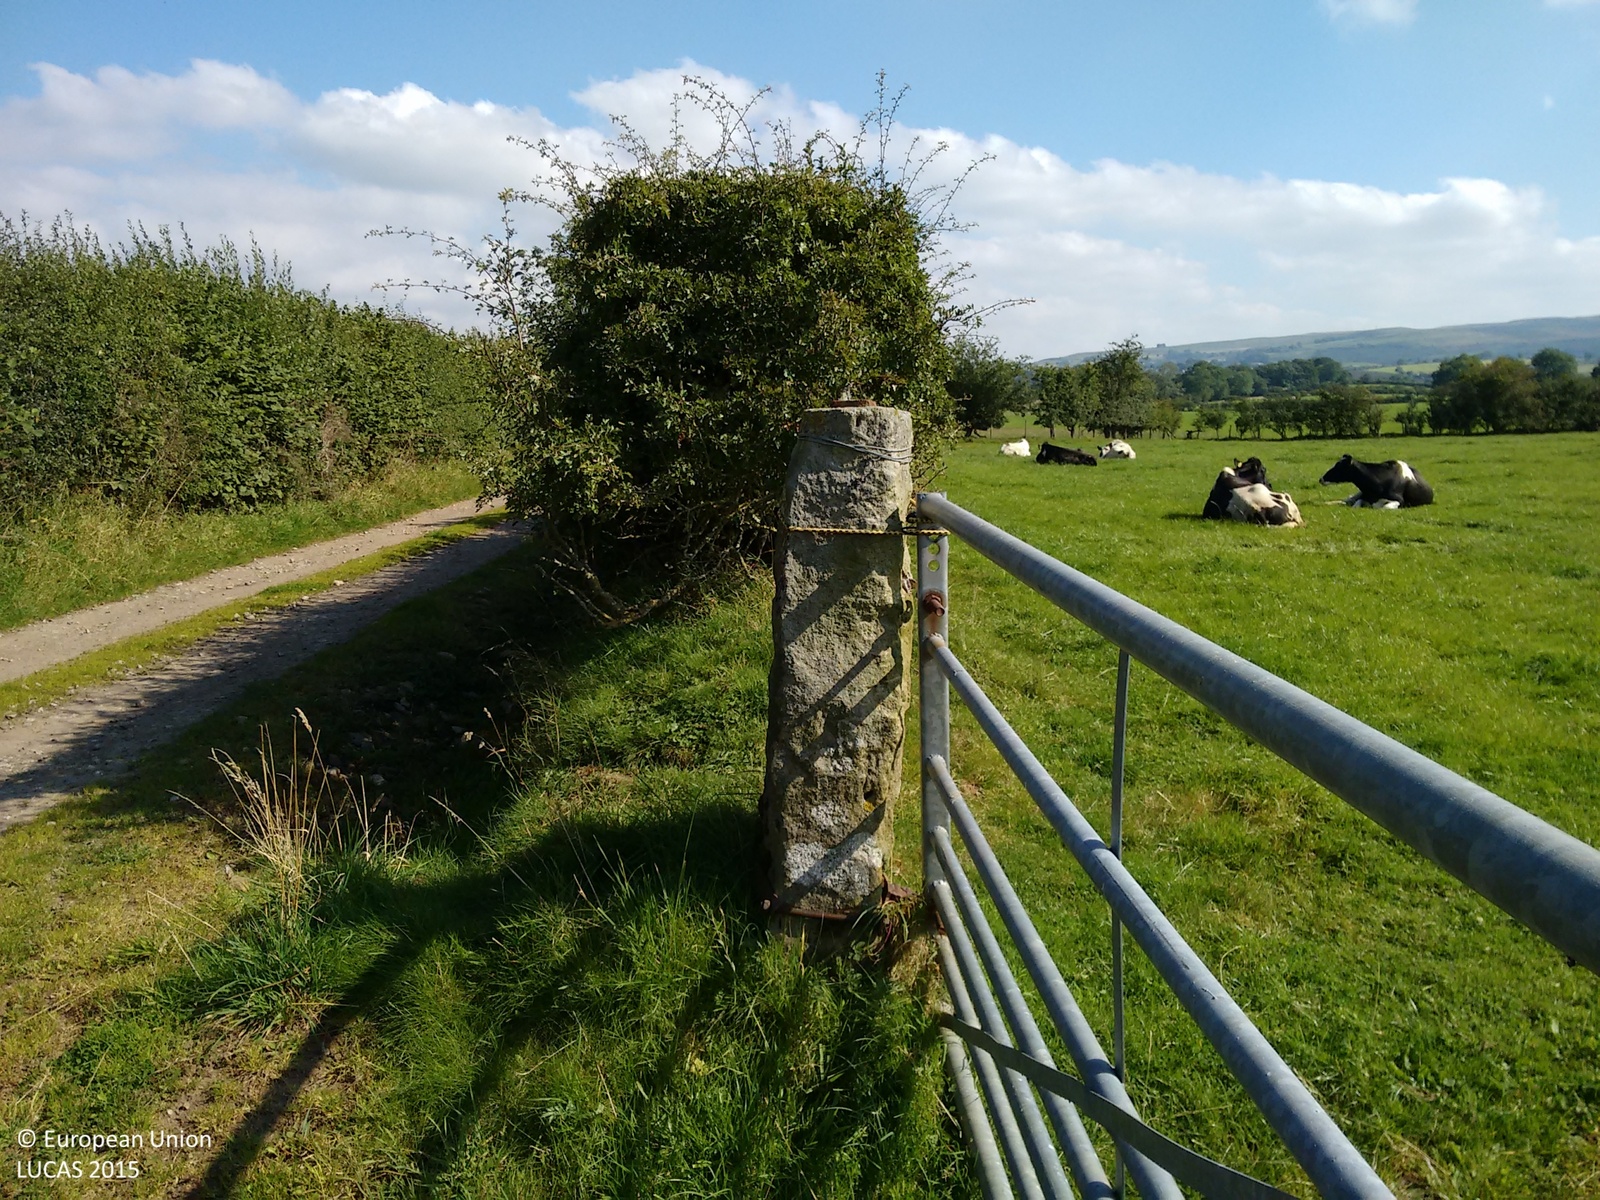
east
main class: Grassland
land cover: Grassland without tree/shrub cover
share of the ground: > 75 %
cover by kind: herbaceous plants 100 %
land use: Agriculture (excluding fallow land and kitchen gardens)
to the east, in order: Grassland without tree/shrub cover; Managed hedges; Fences; Grassland without tree/shrub cover
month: September
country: GB
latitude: 54.5003
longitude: -2.3057
